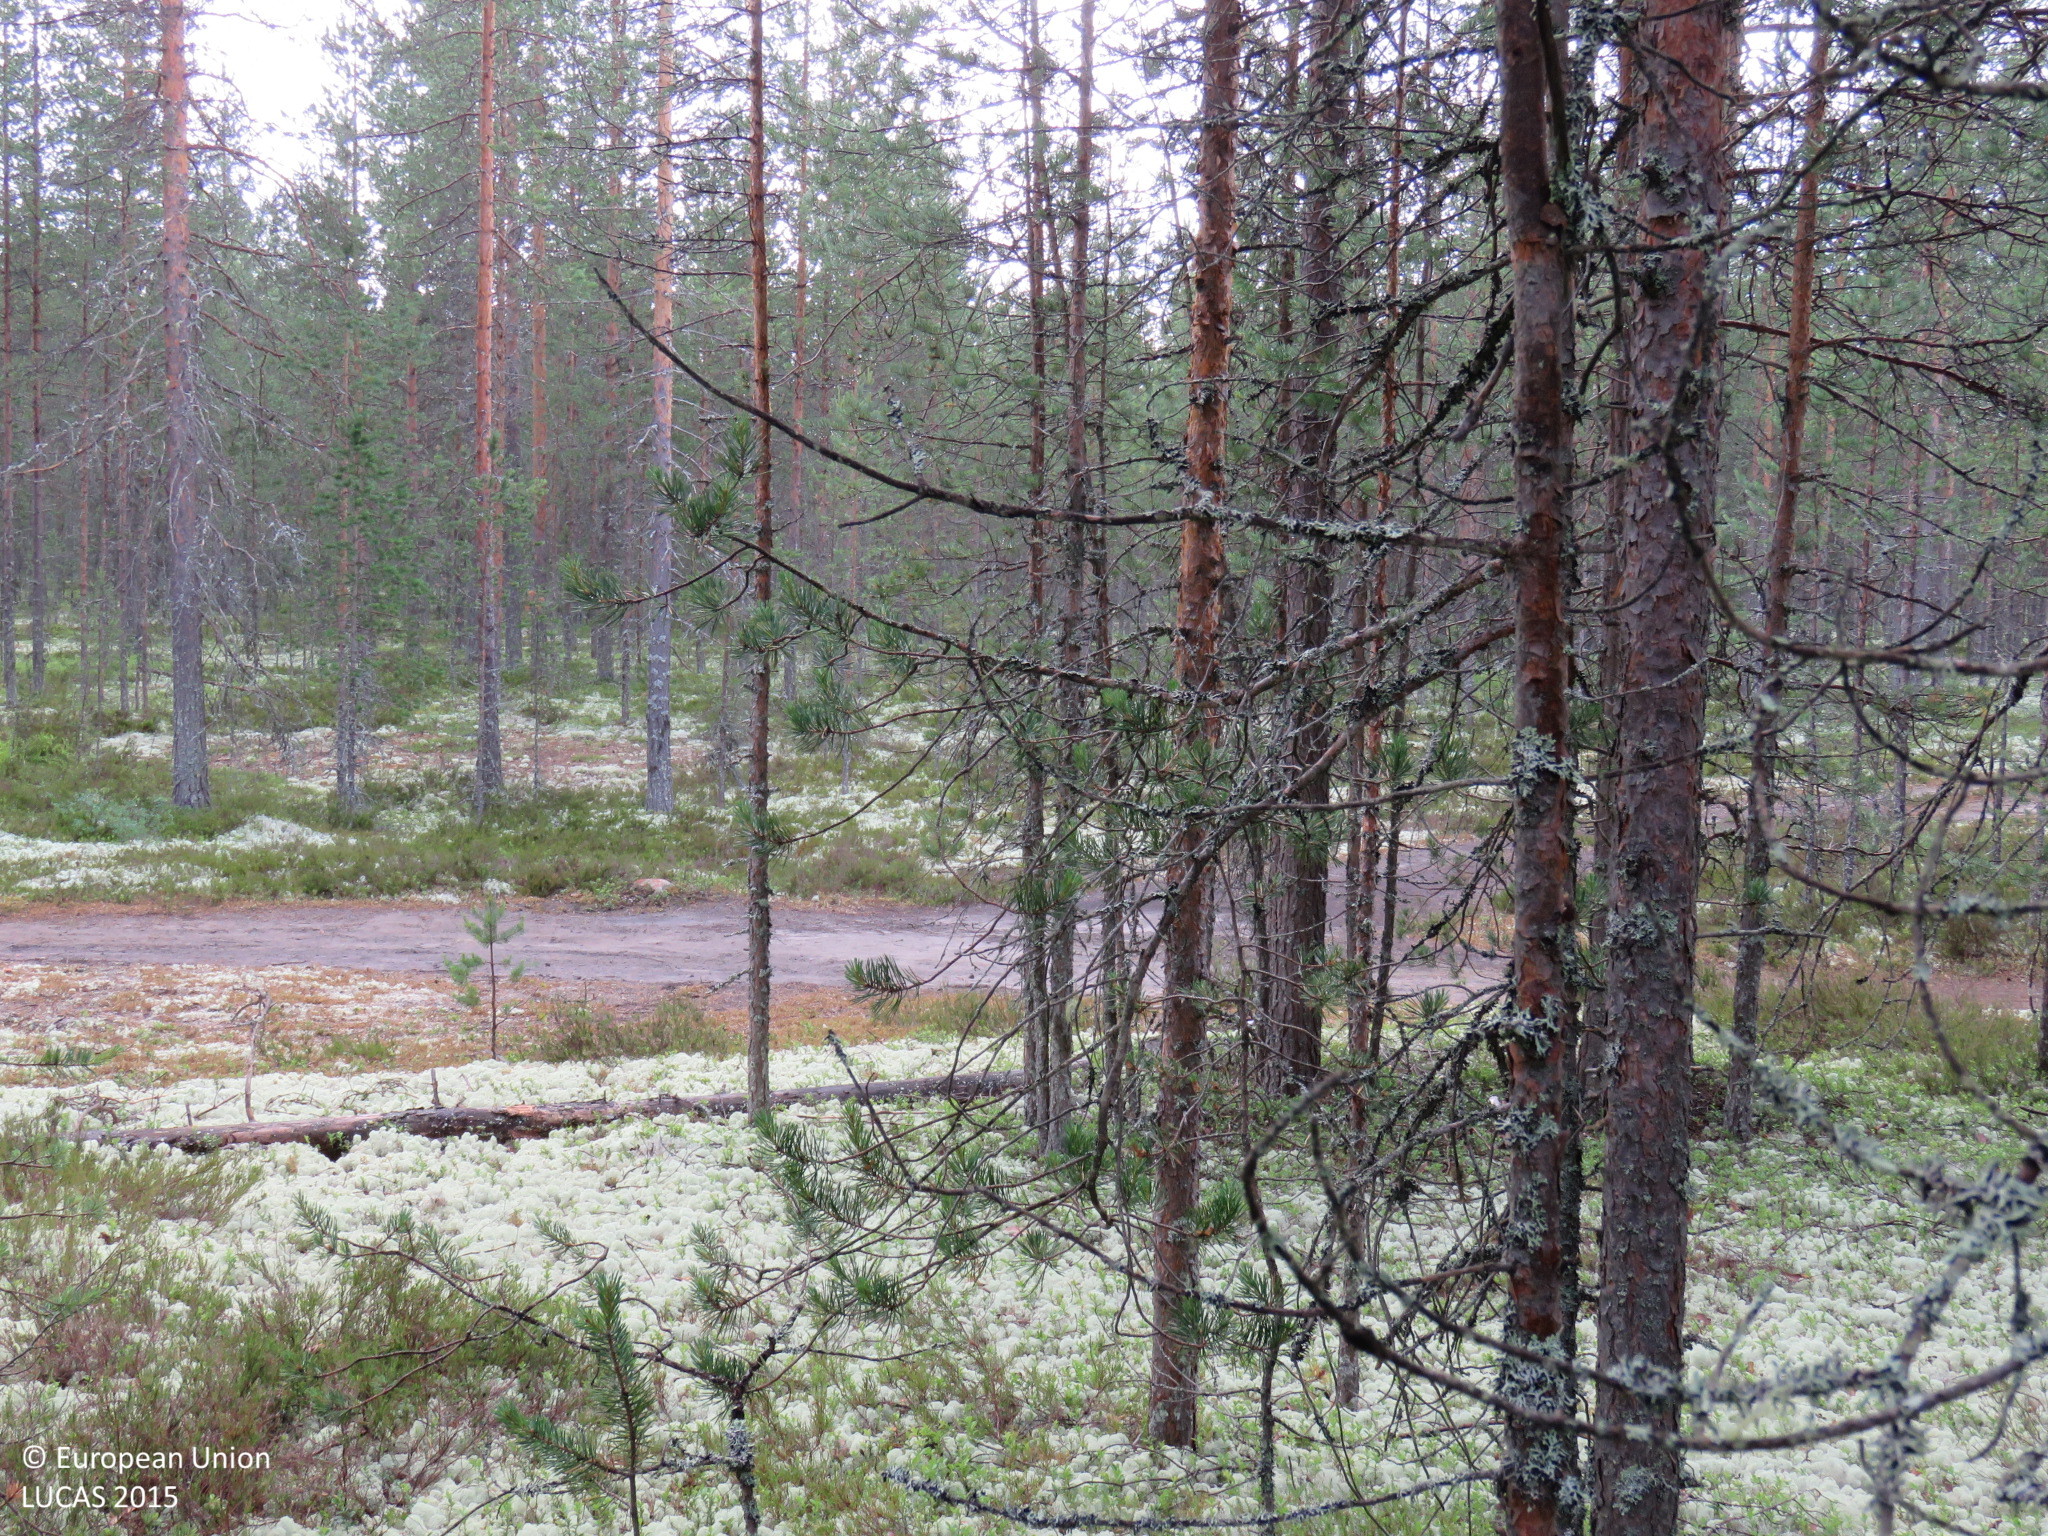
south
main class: Woodland
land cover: Pine dominated coniferous woodland
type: boreal forest
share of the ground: > 75 %
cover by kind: coniferous forest trees 75 %, lichens and mosses 15 %, shrubs 10 %
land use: Forestry
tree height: > 5 m
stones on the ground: < 10 %
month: July
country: FI
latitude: 64.5082
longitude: 26.6748
